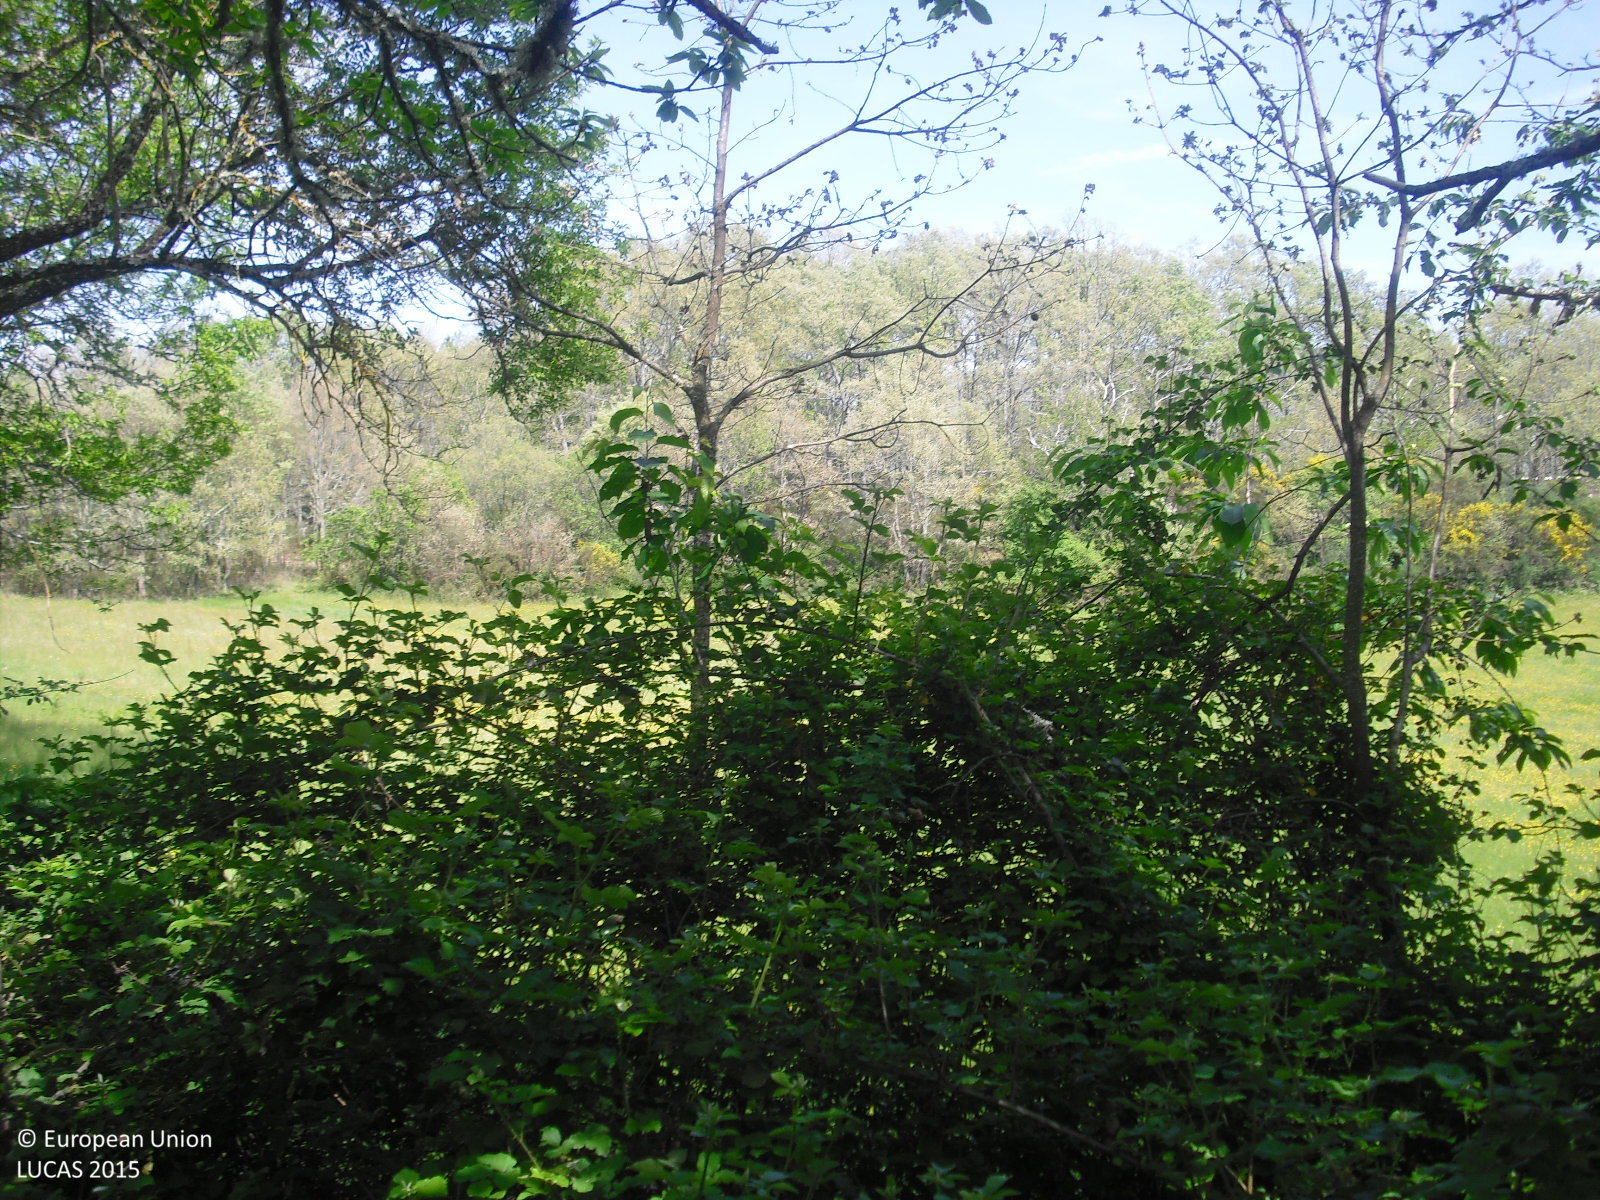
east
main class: Cropland
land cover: Nuts trees
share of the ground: > 75 %
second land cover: Spontaneously vegetated surfaces
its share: > 75 %
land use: Agriculture (excluding fallow land and kitchen gardens)
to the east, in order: Nuts trees; Spontaneously vegetated surfaces; Shruby margins; Dry stone walls; Grassland without tree/shrub cover; Rock outcrops; Broadleaved woodland; Dry stone walls; Broadleaved woodland; Dry stone walls; Broadleaved woodland; Electric lines; Broadleaved woodland; Dry stone walls; Shruby margins; Ditches and canals; Paved roads, cycling and walking lanes; Ditches and canals; Shruby margins; Fences; Nuts trees; Fences; Nuts trees
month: May
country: ES
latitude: 41.9022
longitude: -7.3305
